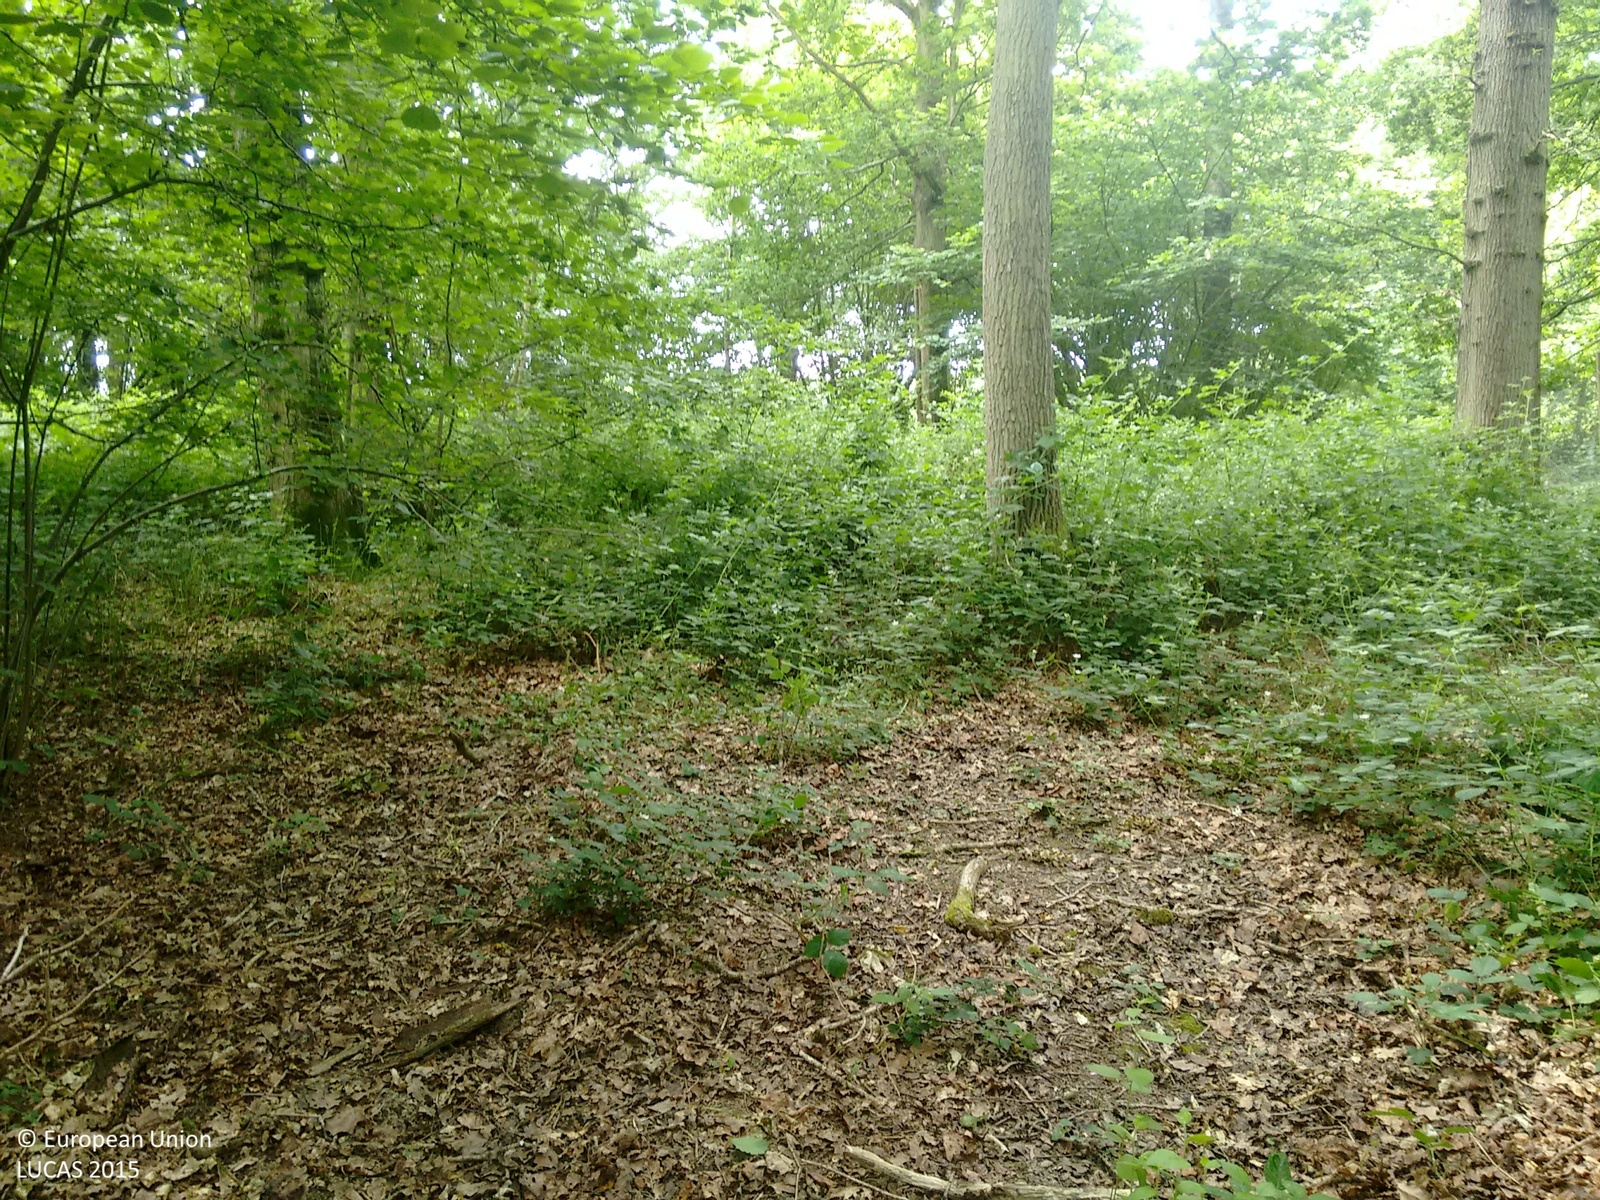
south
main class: Woodland
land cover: Broadleaved woodland
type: mesophytic deciduous forest
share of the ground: > 75 %
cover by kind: broadleaved forest trees 90 %, shrubs 10 %
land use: Semi-natural and natural areas not in use
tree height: > 5 m
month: July
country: GB
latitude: 50.9541
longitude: -0.0408
